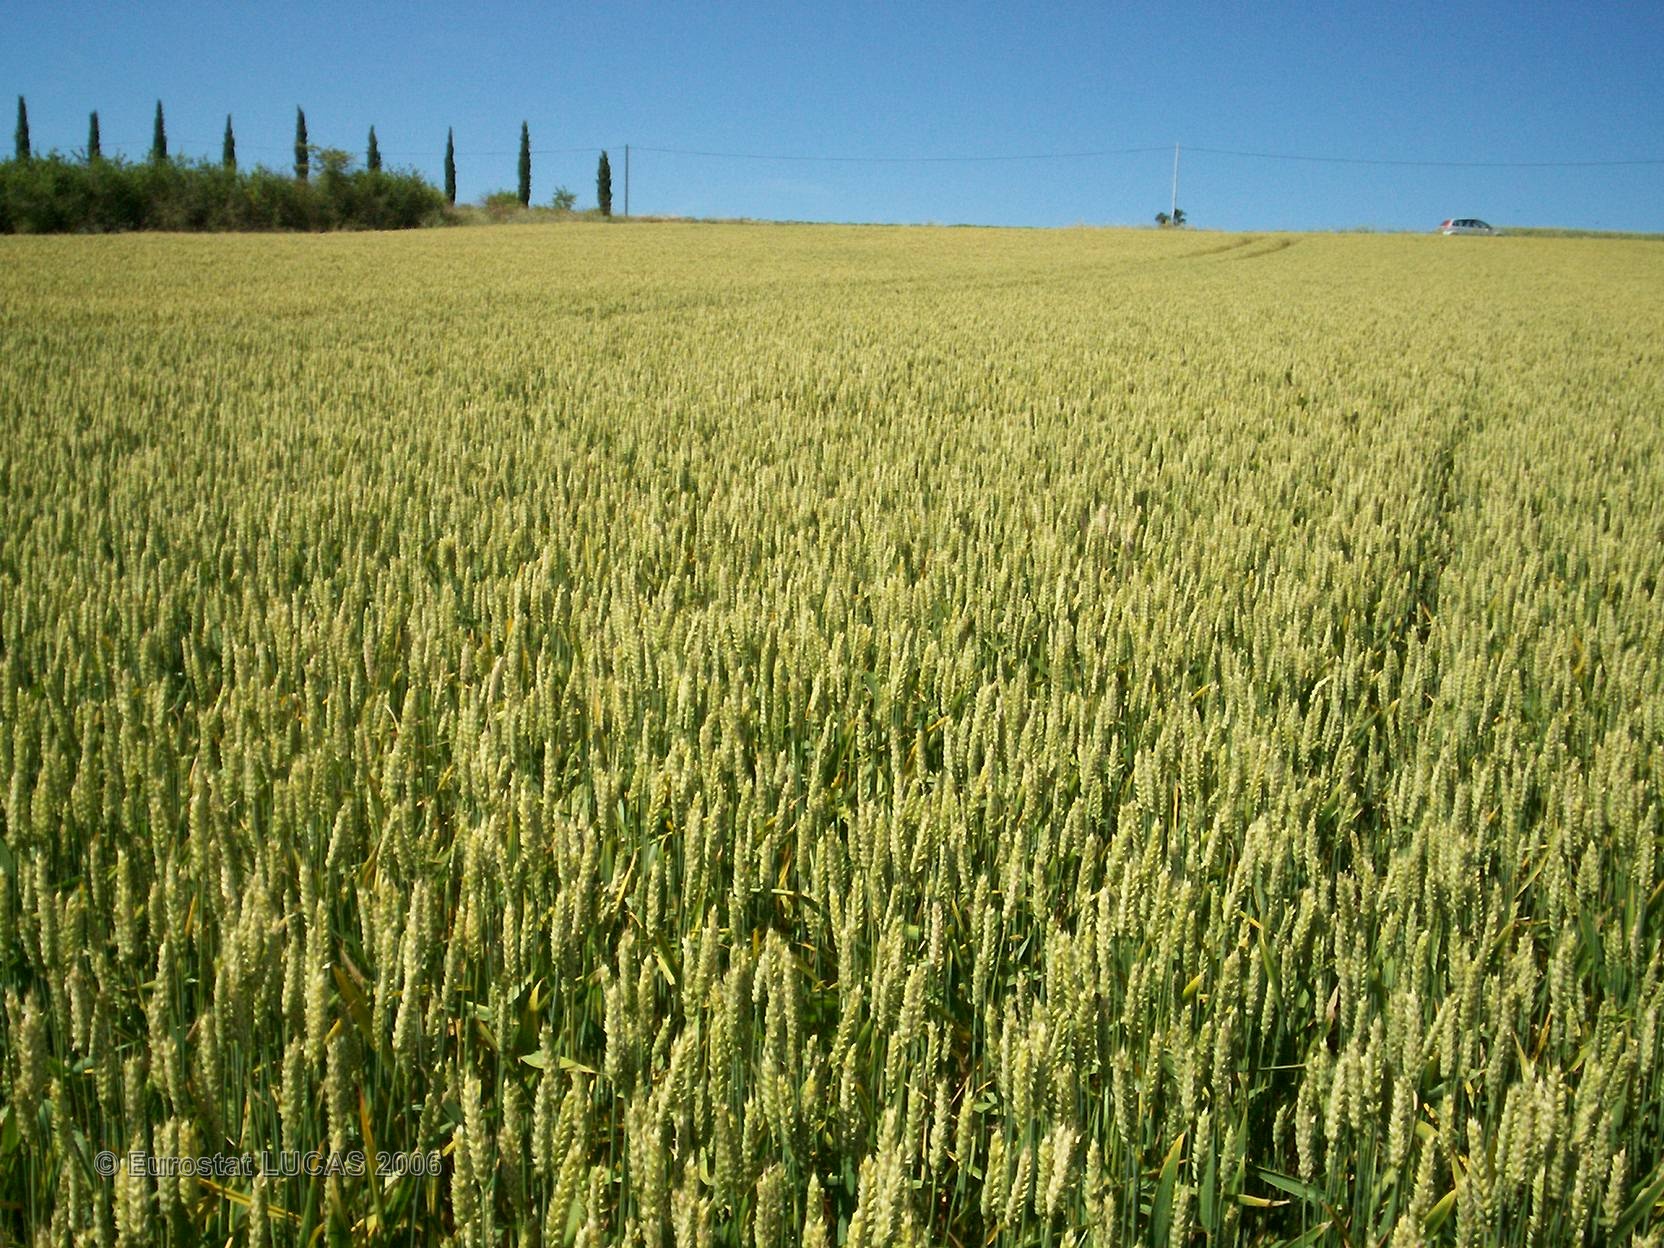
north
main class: Cropland
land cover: Common wheat
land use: Agriculture (excluding fallow land and kitchen gardens)
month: June
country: FR
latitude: 43.9067
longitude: 0.8209
